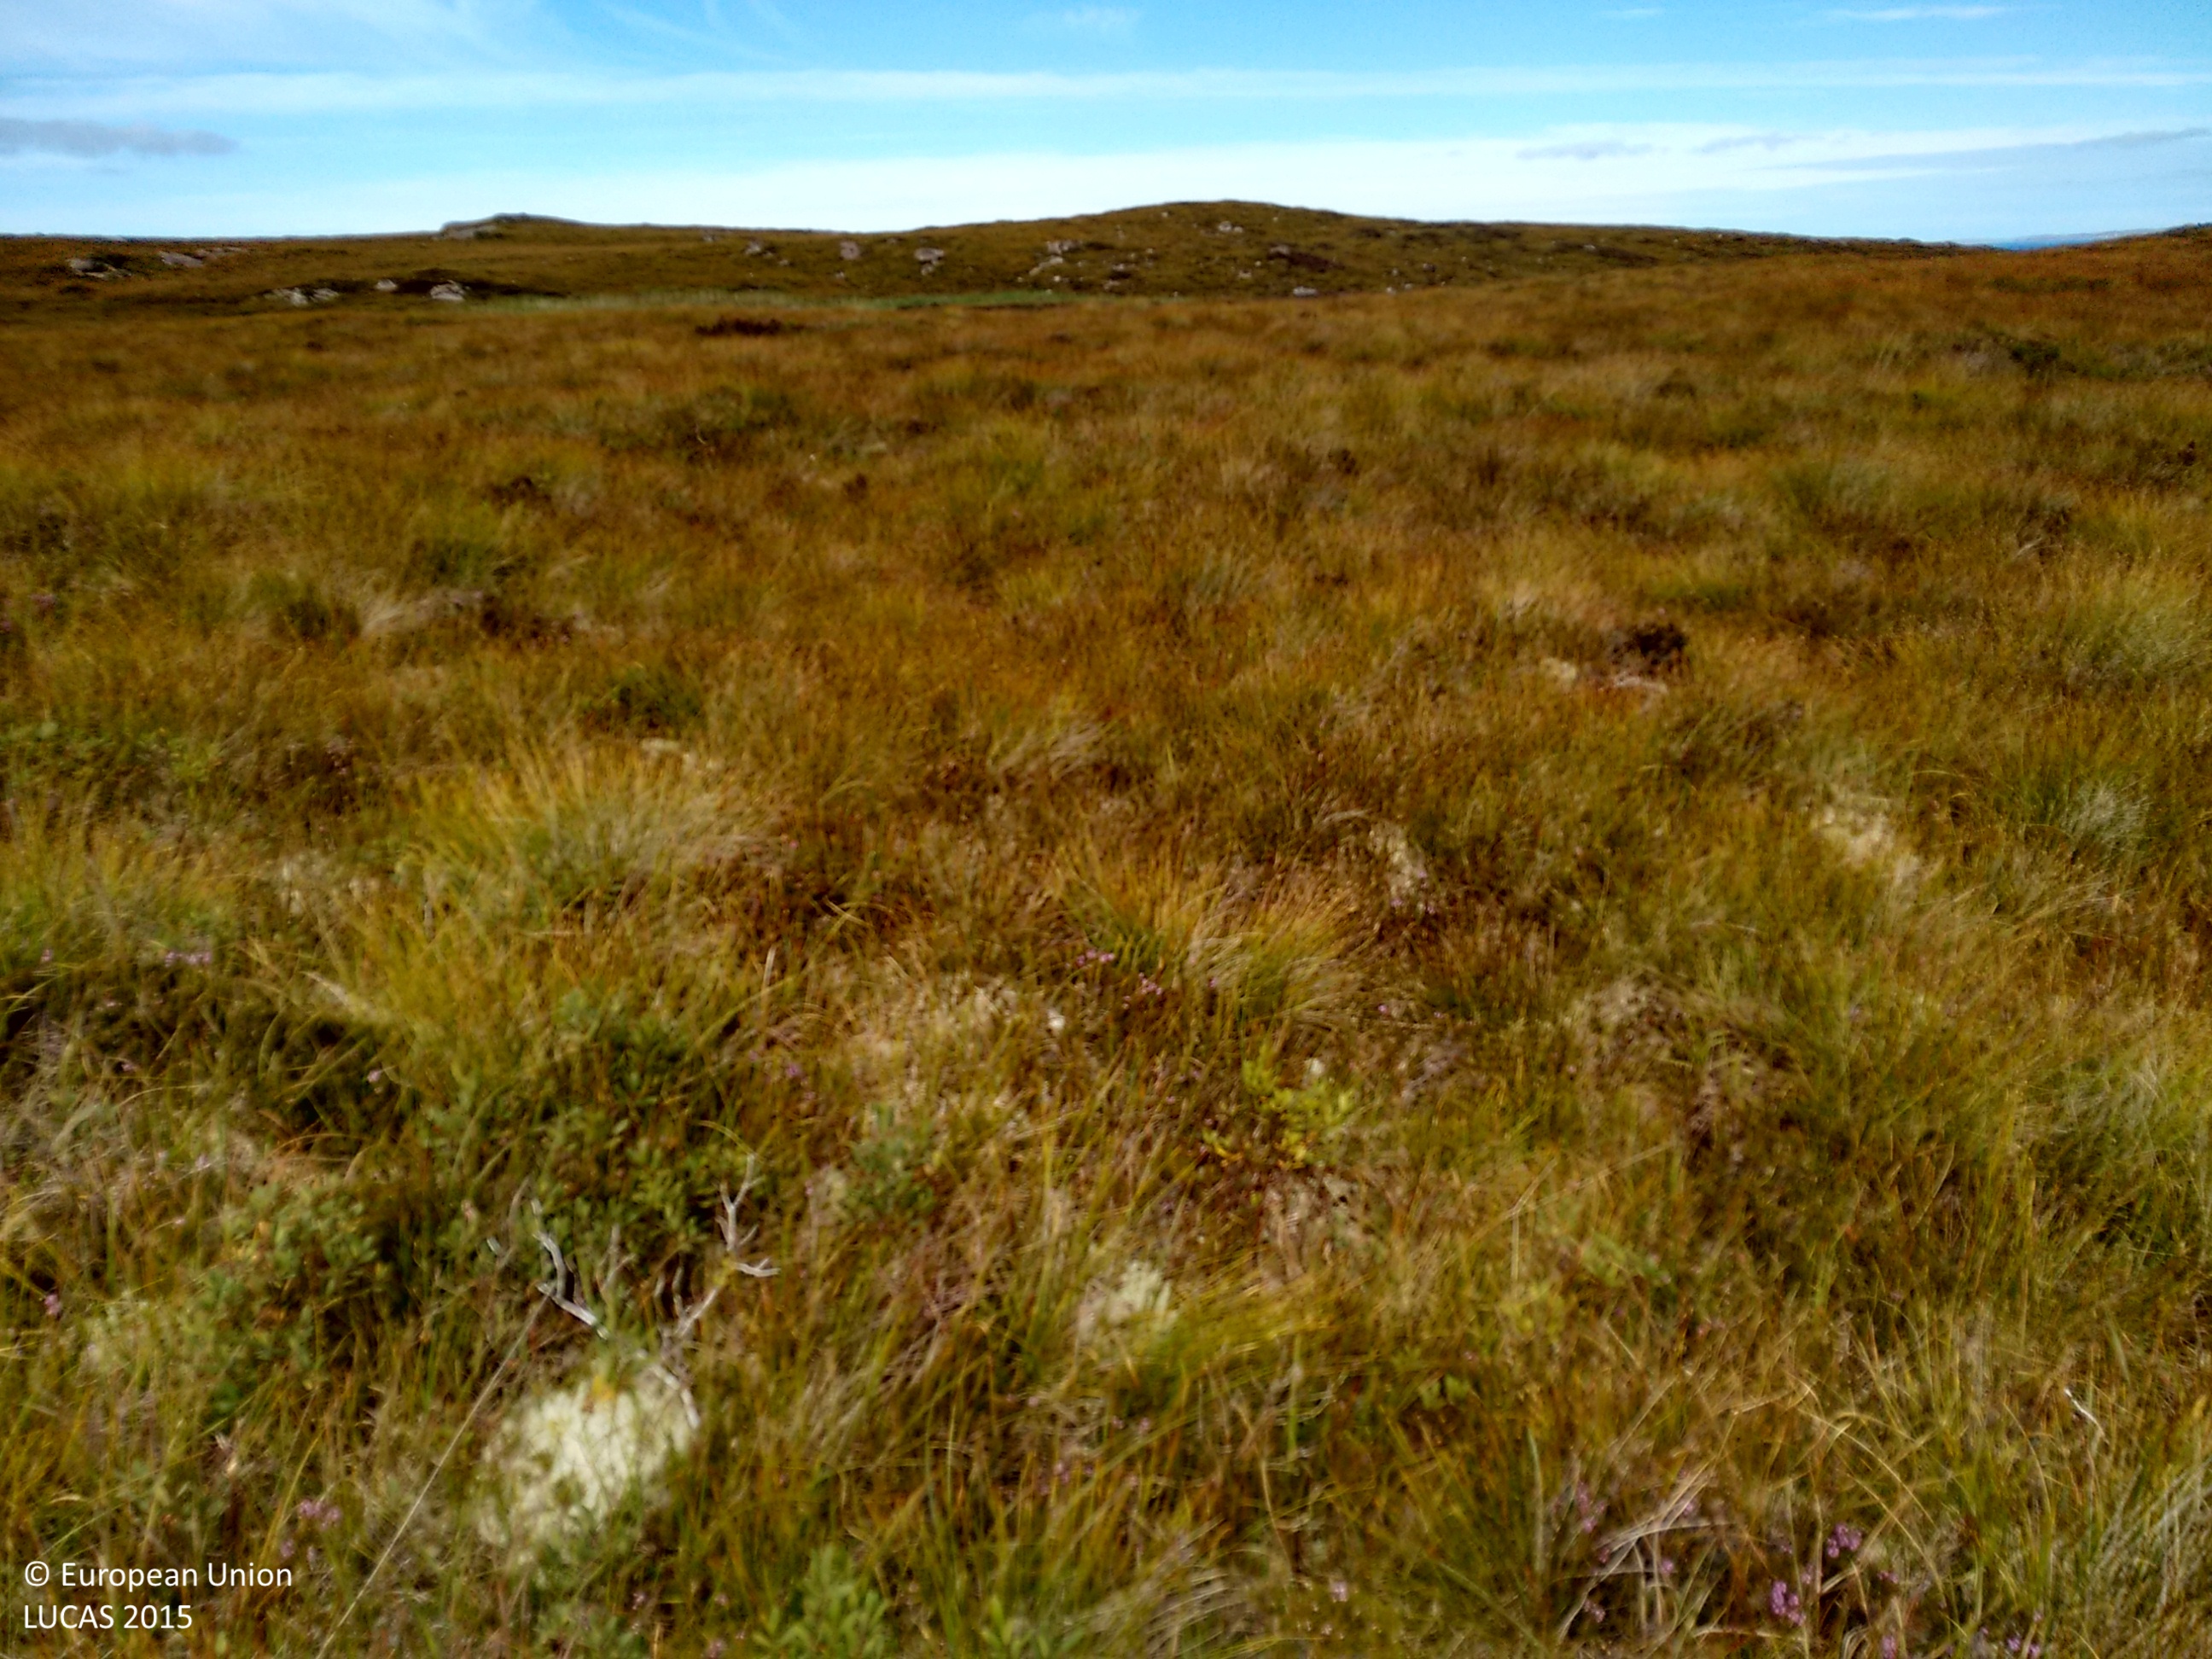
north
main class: Shrubland
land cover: Shrubland without tree cover
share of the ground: 25 - 50 %
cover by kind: shrubs 50 %, herbaceous plants 50 %
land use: Semi-natural and natural areas not in use
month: September
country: GB
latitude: 57.9077
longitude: -5.5901
